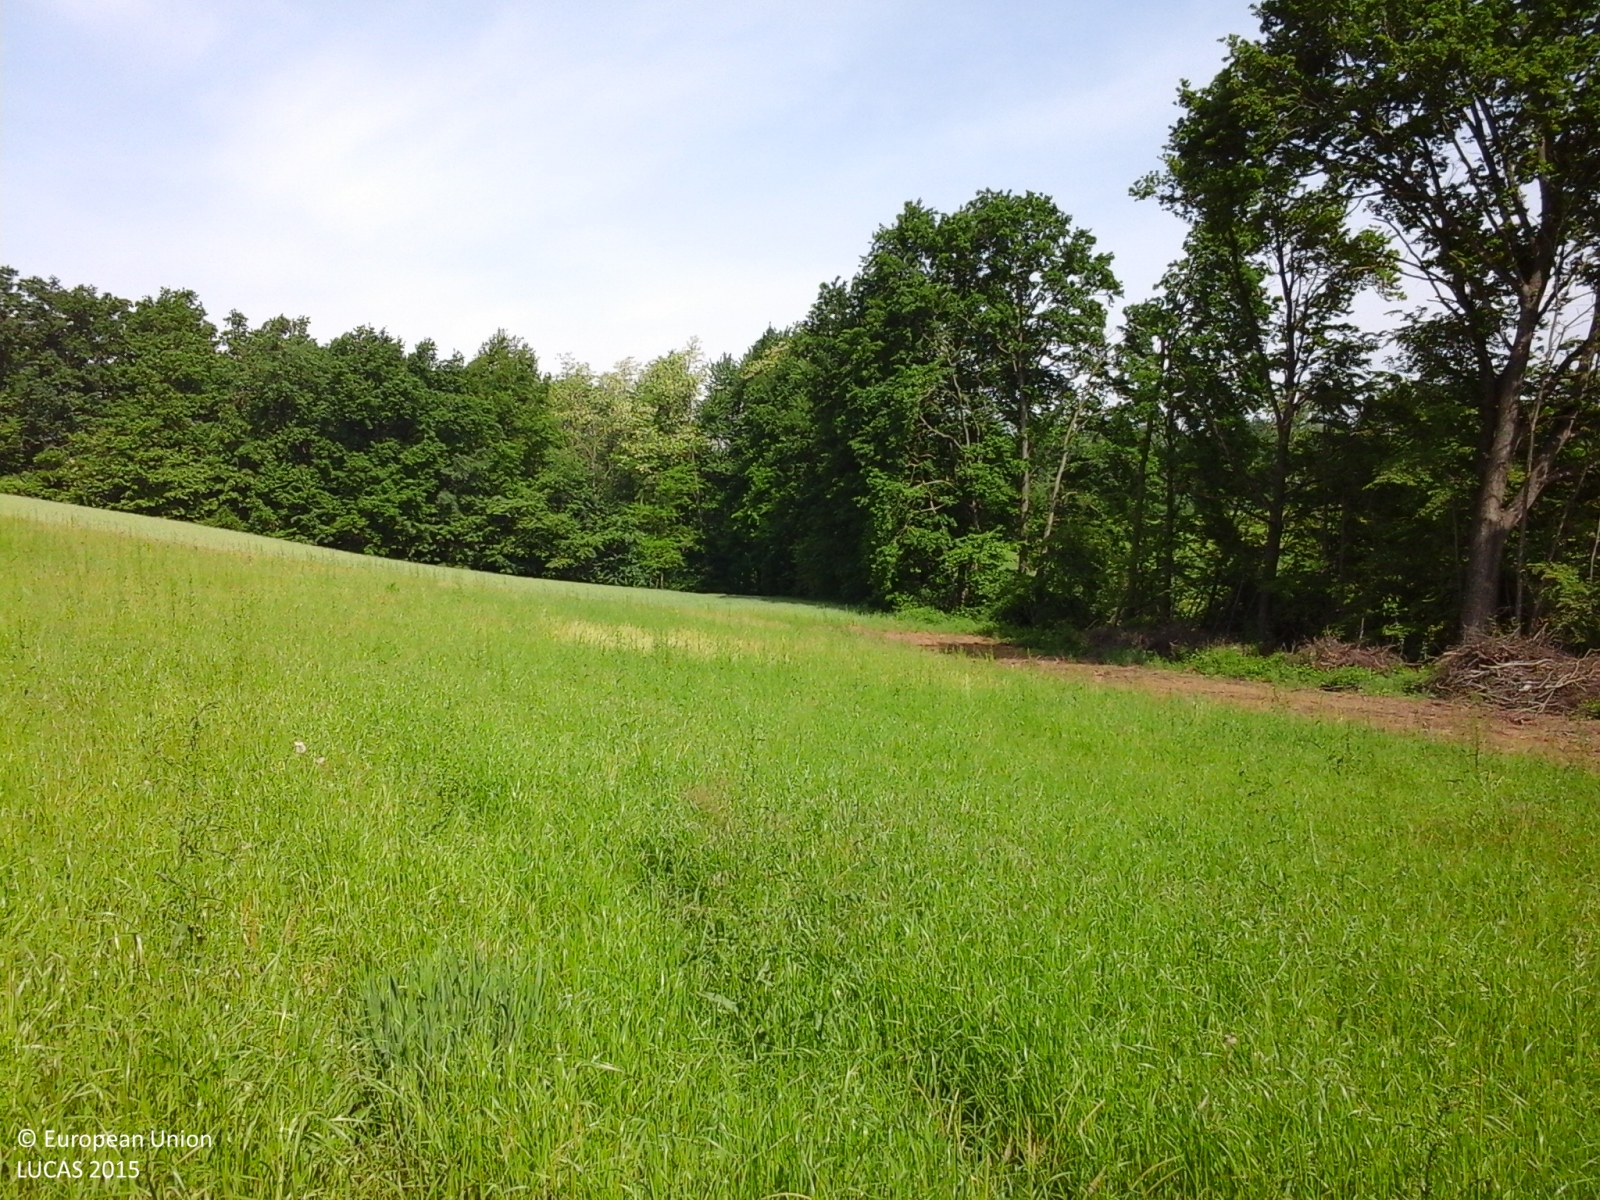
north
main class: Cropland
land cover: Temporary grasslands
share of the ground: > 75 %
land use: Agriculture (excluding fallow land and kitchen gardens)
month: May
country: IT
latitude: 44.9333
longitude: 8.3938
